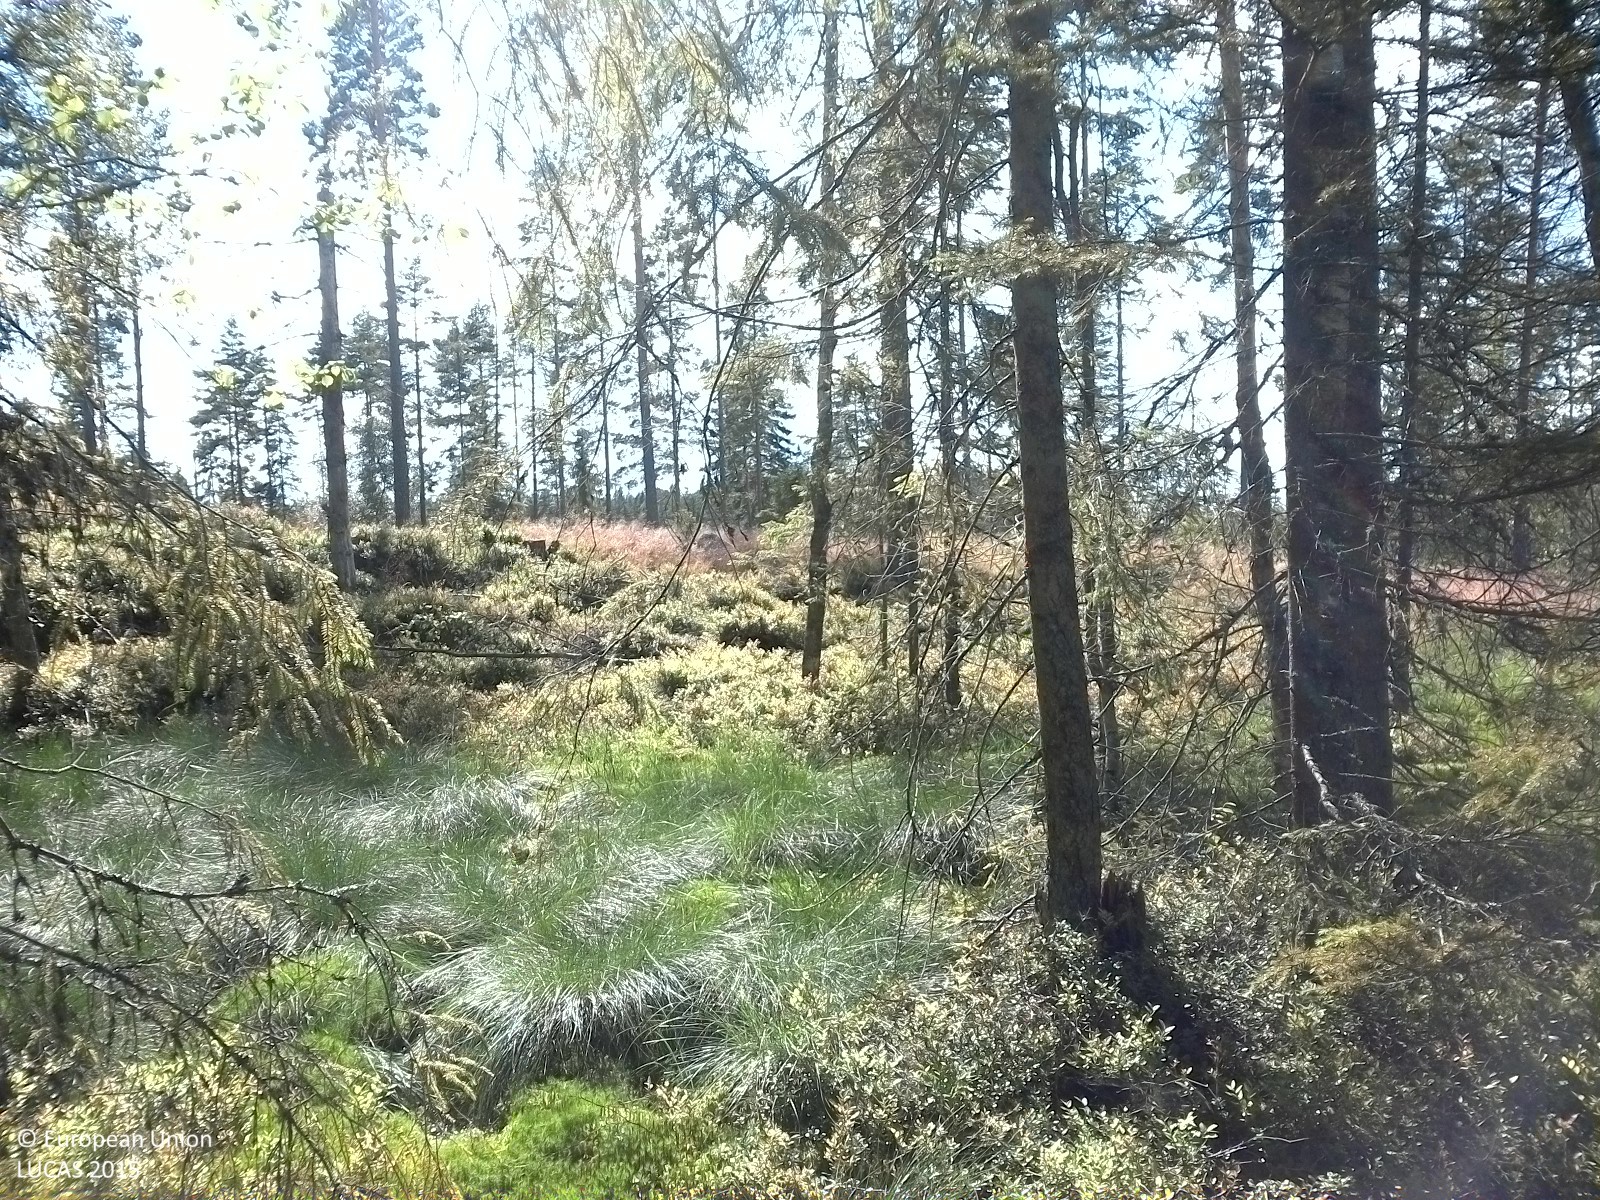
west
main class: Woodland
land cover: Pine dominated mixed woodland
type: boreal forest
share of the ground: 25 - 50 %
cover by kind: herbaceous plants 45 %, coniferous forest trees 20 %, shrubs 15 %, broadleaved forest trees 10 %, lichens and mosses 10 %
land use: Forestry
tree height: > 5 m
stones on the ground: < 10 %
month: August
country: SE
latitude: 58.9527
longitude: 15.0859
